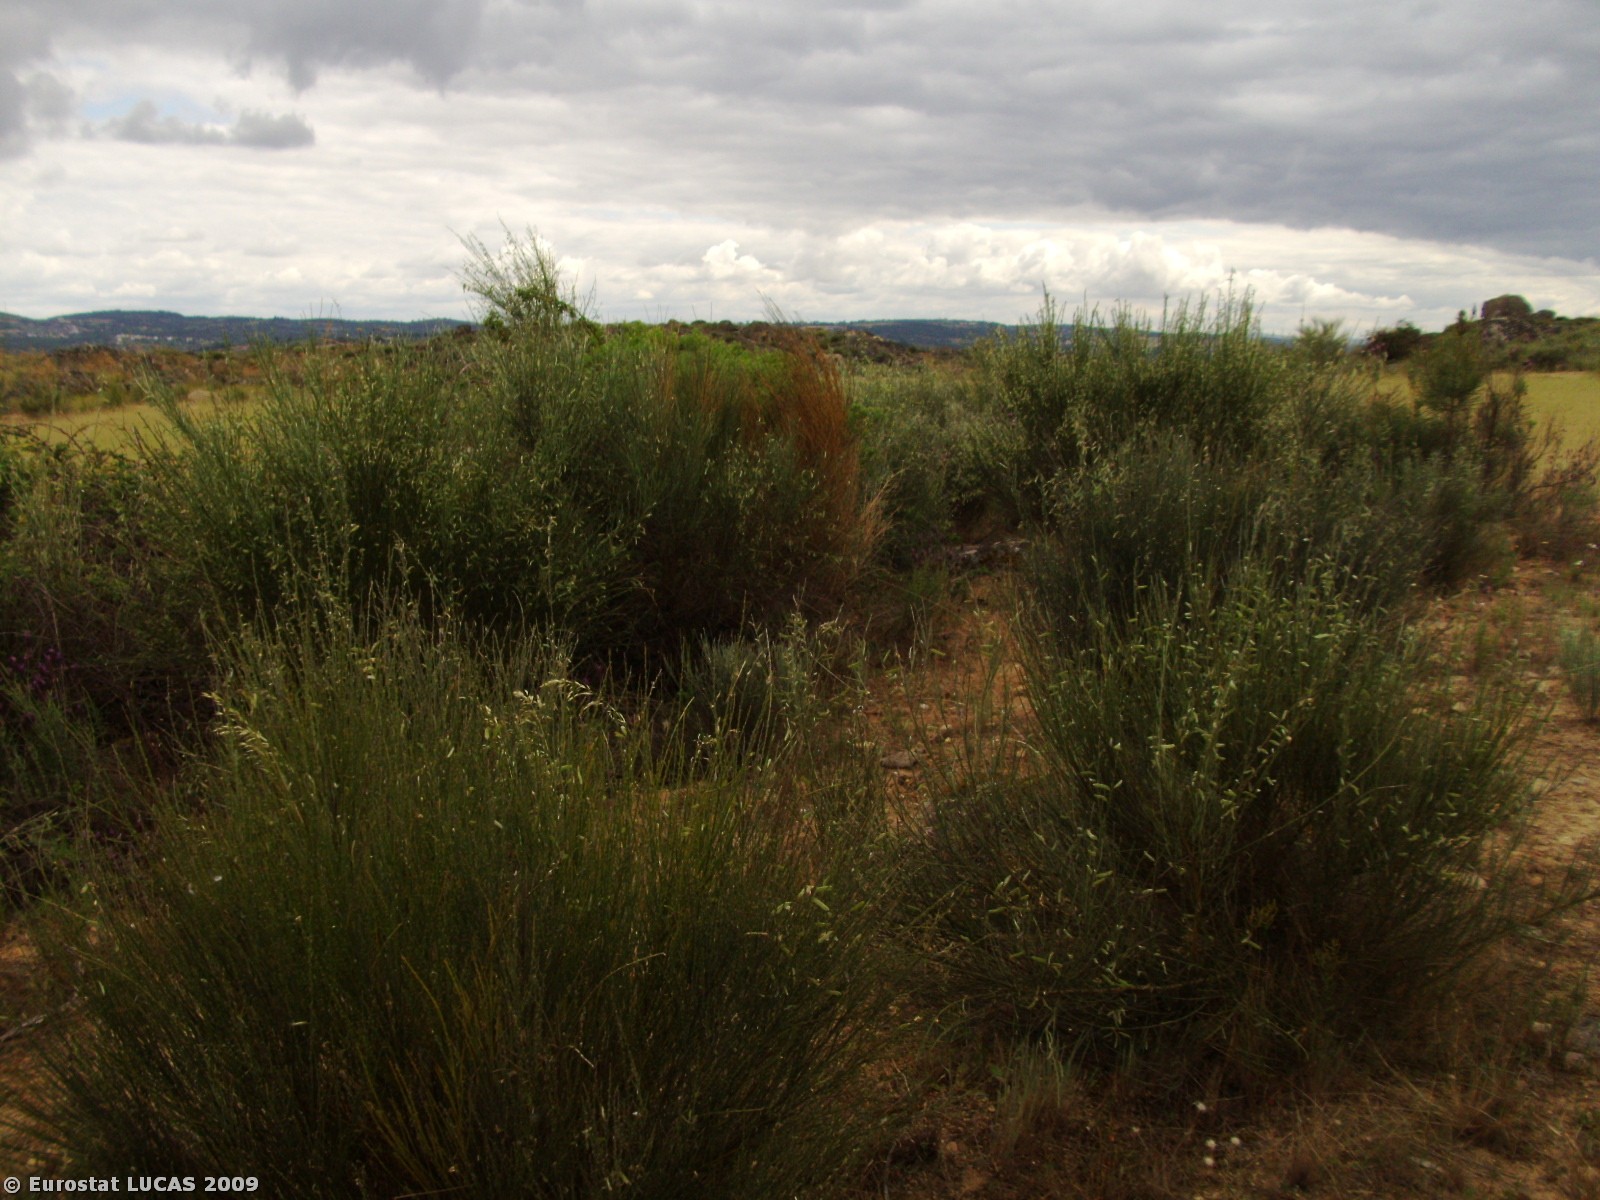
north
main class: Shrubland
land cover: Shrubland without tree cover
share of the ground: 25 - 50 %
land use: Nature reserves
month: May
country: PT
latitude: 40.8989
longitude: -7.1670
